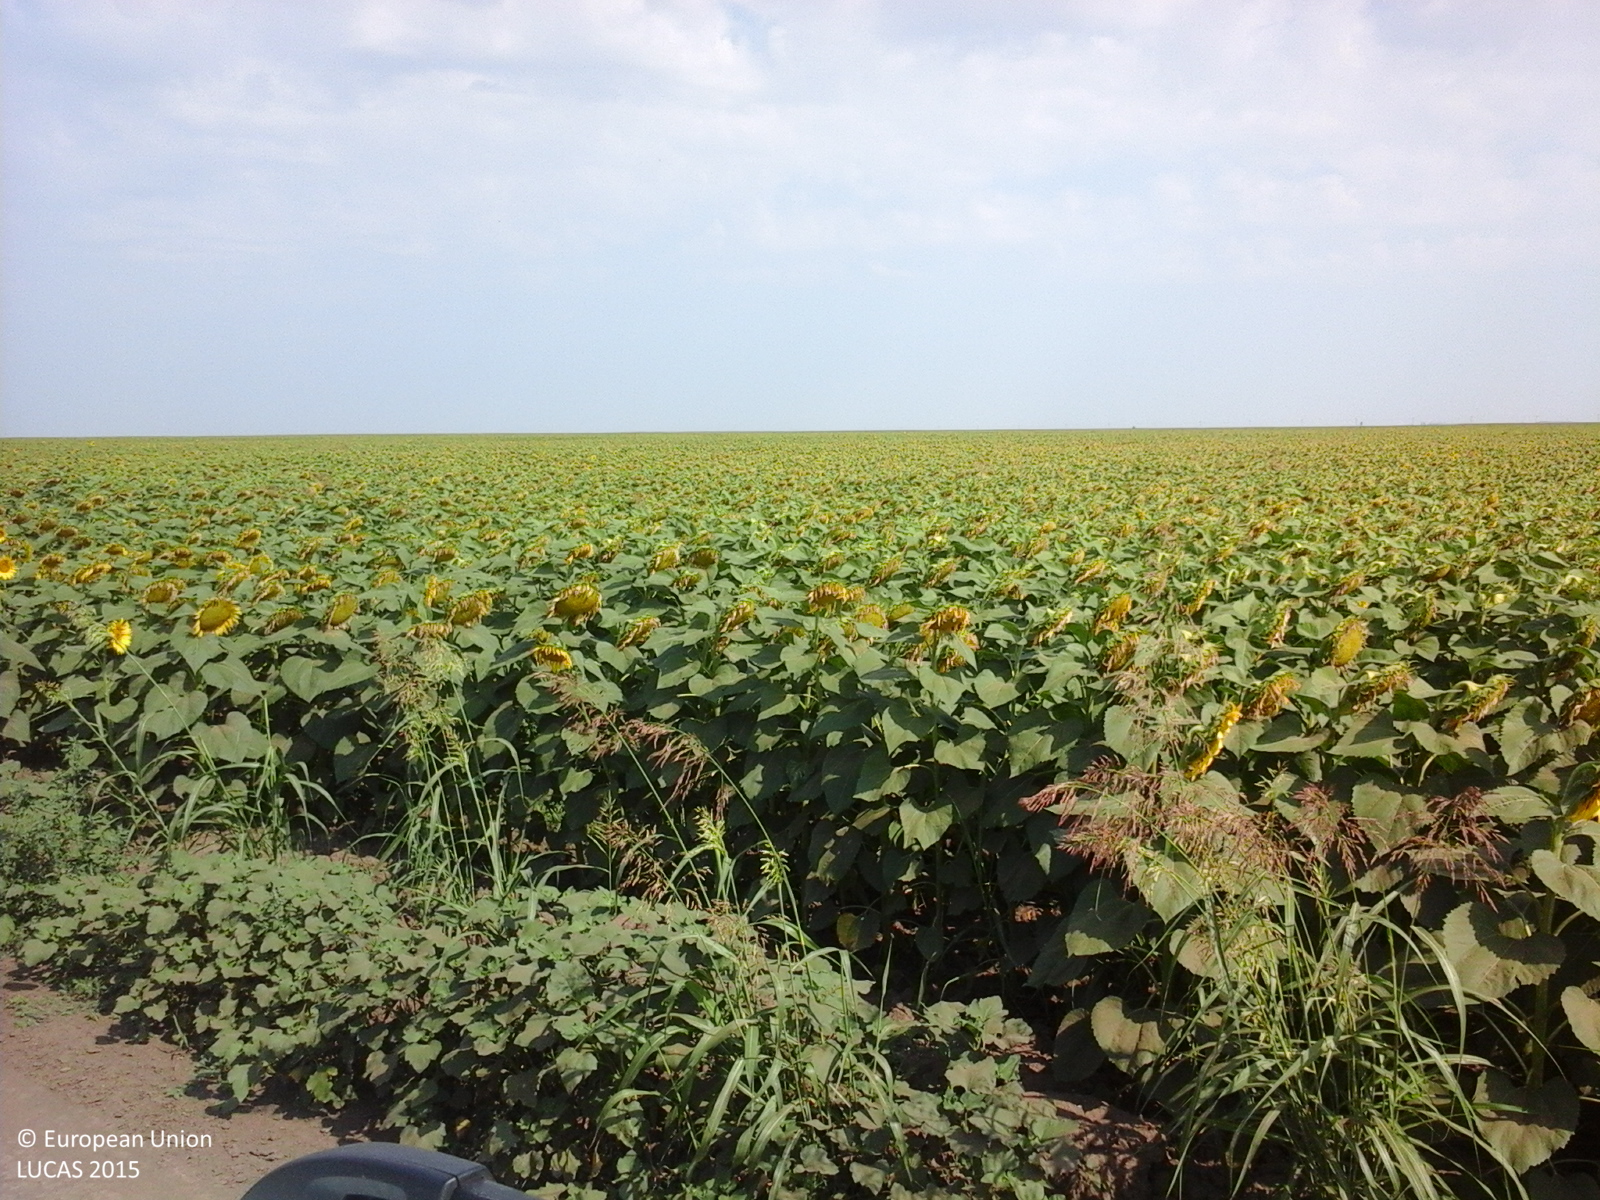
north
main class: Cropland
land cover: Maize
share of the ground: > 75 %
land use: Agriculture (excluding fallow land and kitchen gardens)
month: July
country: RO
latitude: 44.6464
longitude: 27.2212
